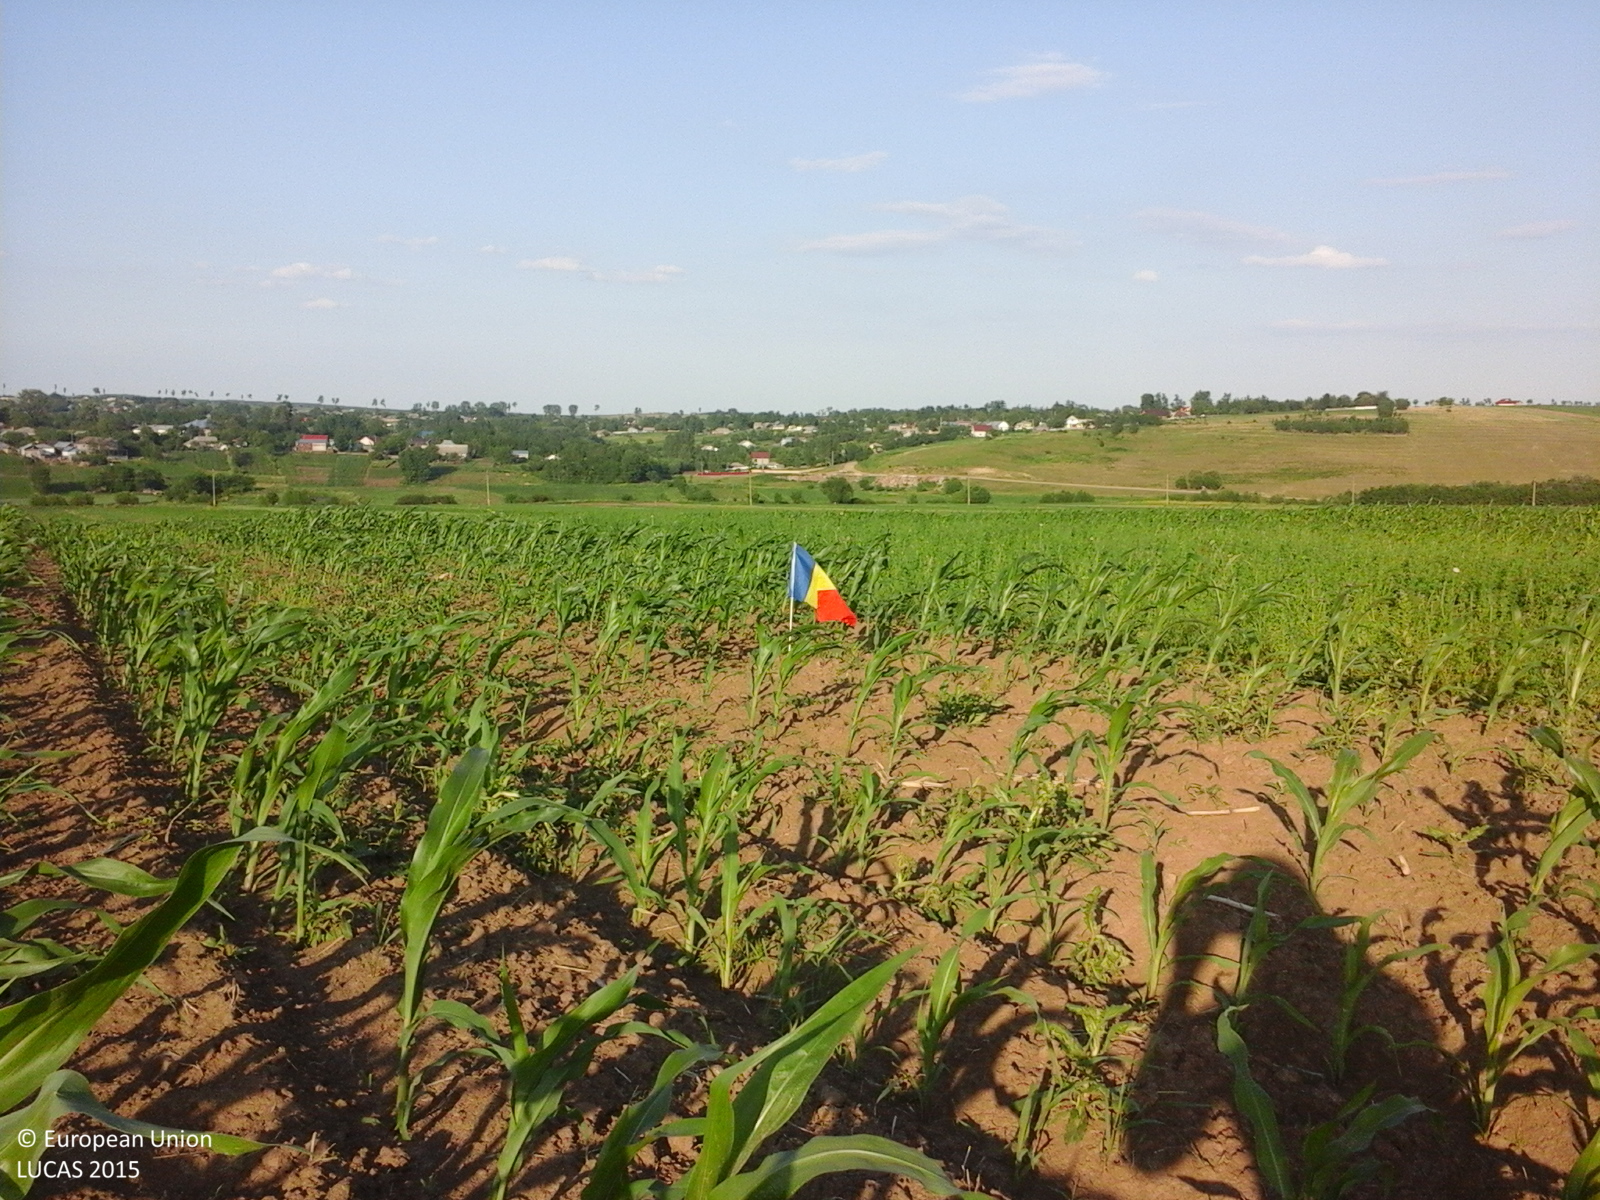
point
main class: Cropland
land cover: Maize
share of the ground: 25 - 50 %
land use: Agriculture (excluding fallow land and kitchen gardens)
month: June
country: RO
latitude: 47.7080
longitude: 26.4692
